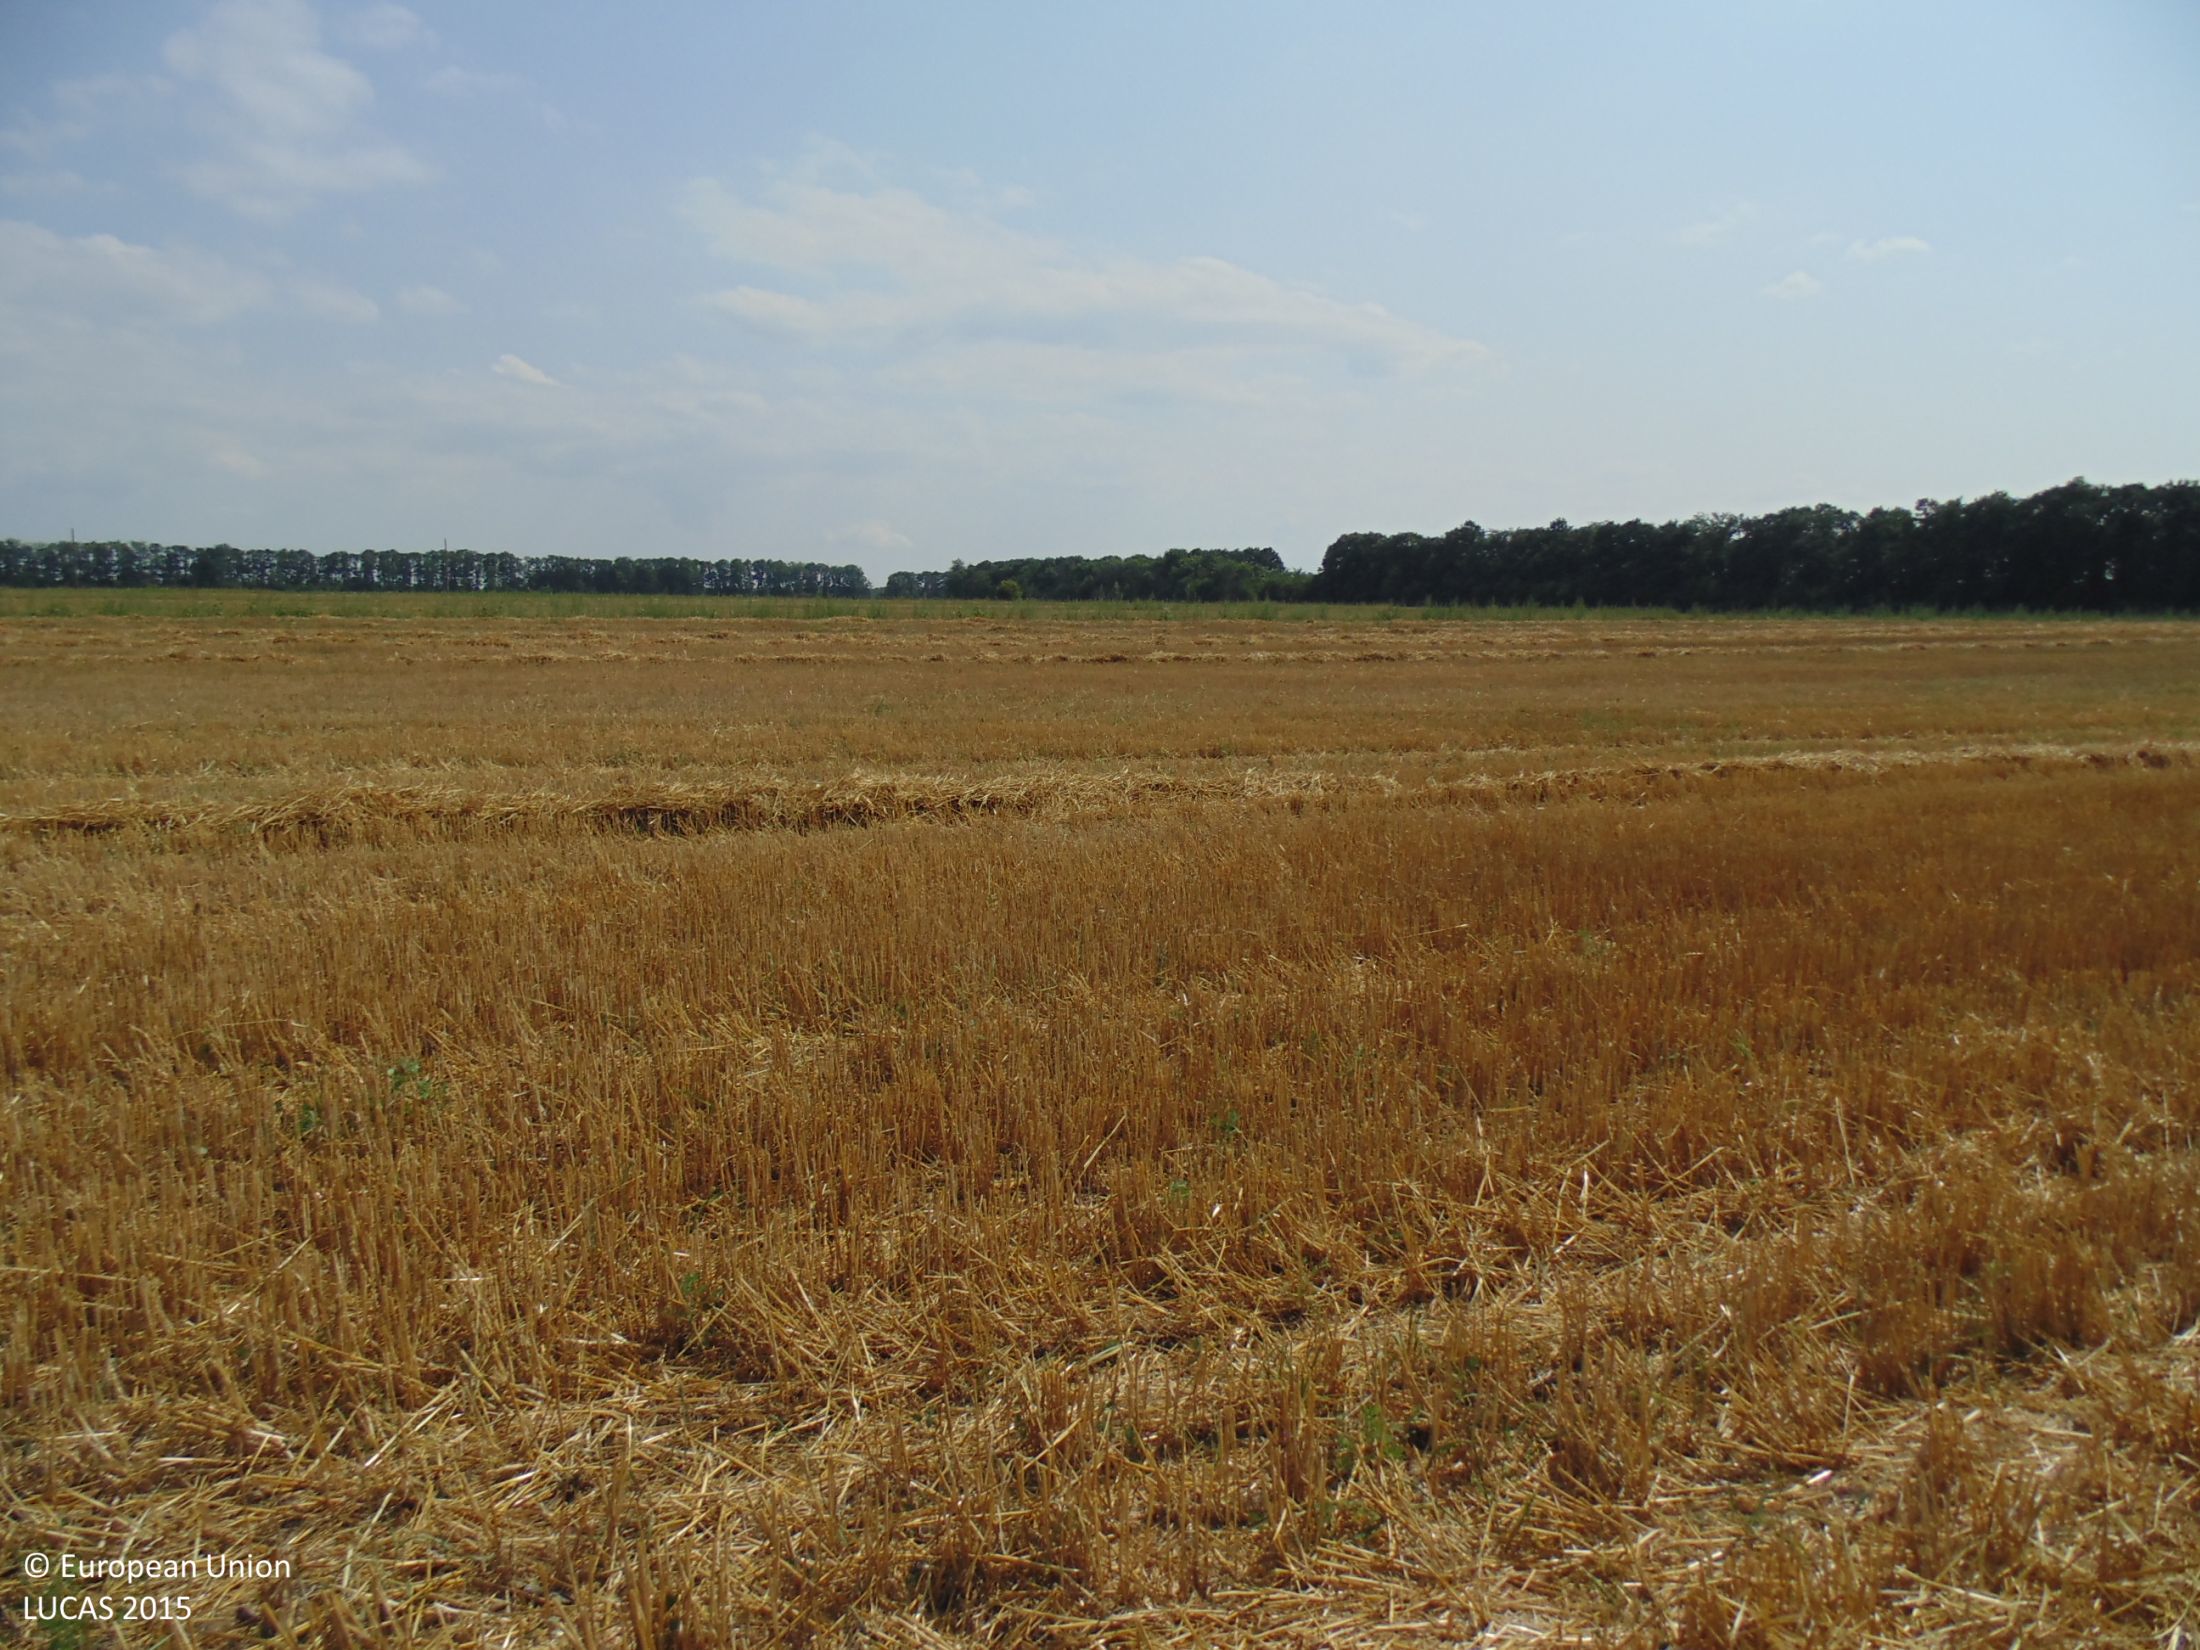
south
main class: Cropland
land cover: Common wheat
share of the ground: 25 - 50 %
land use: Agriculture (excluding fallow land and kitchen gardens)
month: July
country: BG
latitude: 43.6438
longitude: 28.0118
